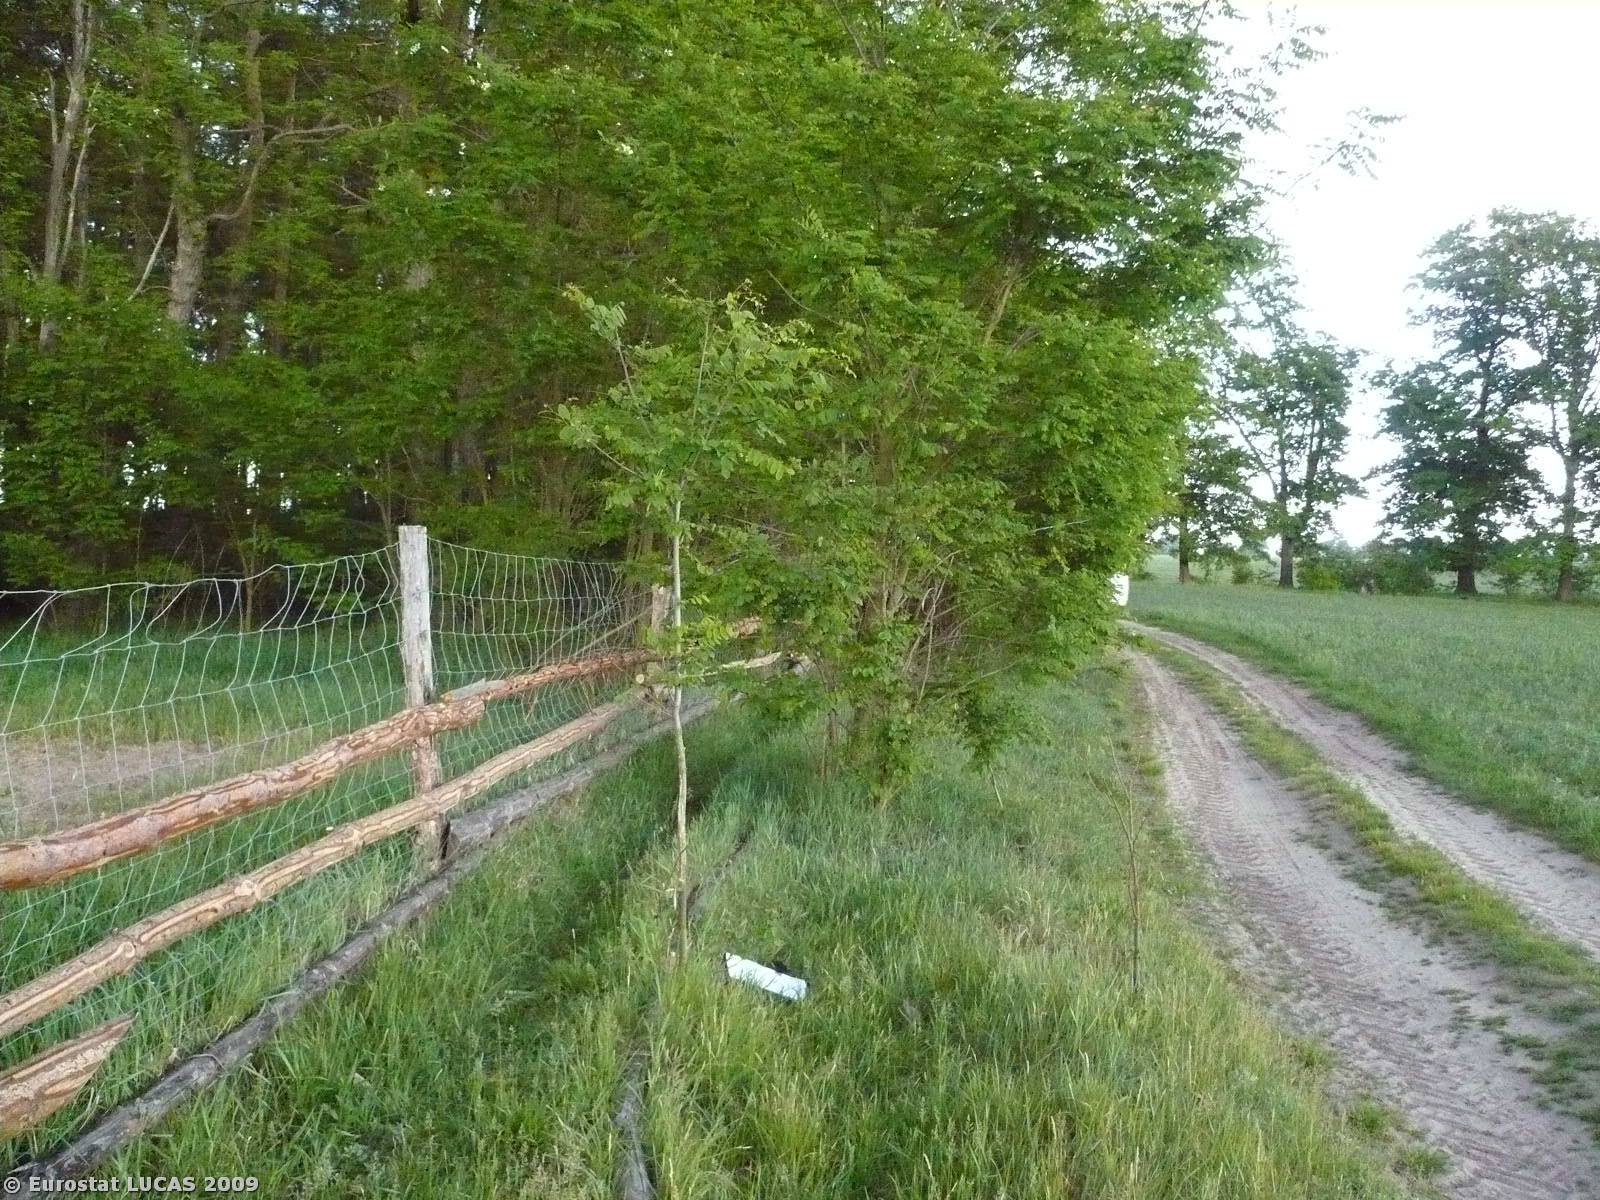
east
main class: Cropland
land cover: Maize
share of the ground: < 10 %
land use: Agriculture (excluding fallow land and kitchen gardens)
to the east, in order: Maize
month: May
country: PL
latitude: 52.1315
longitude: 15.3358
